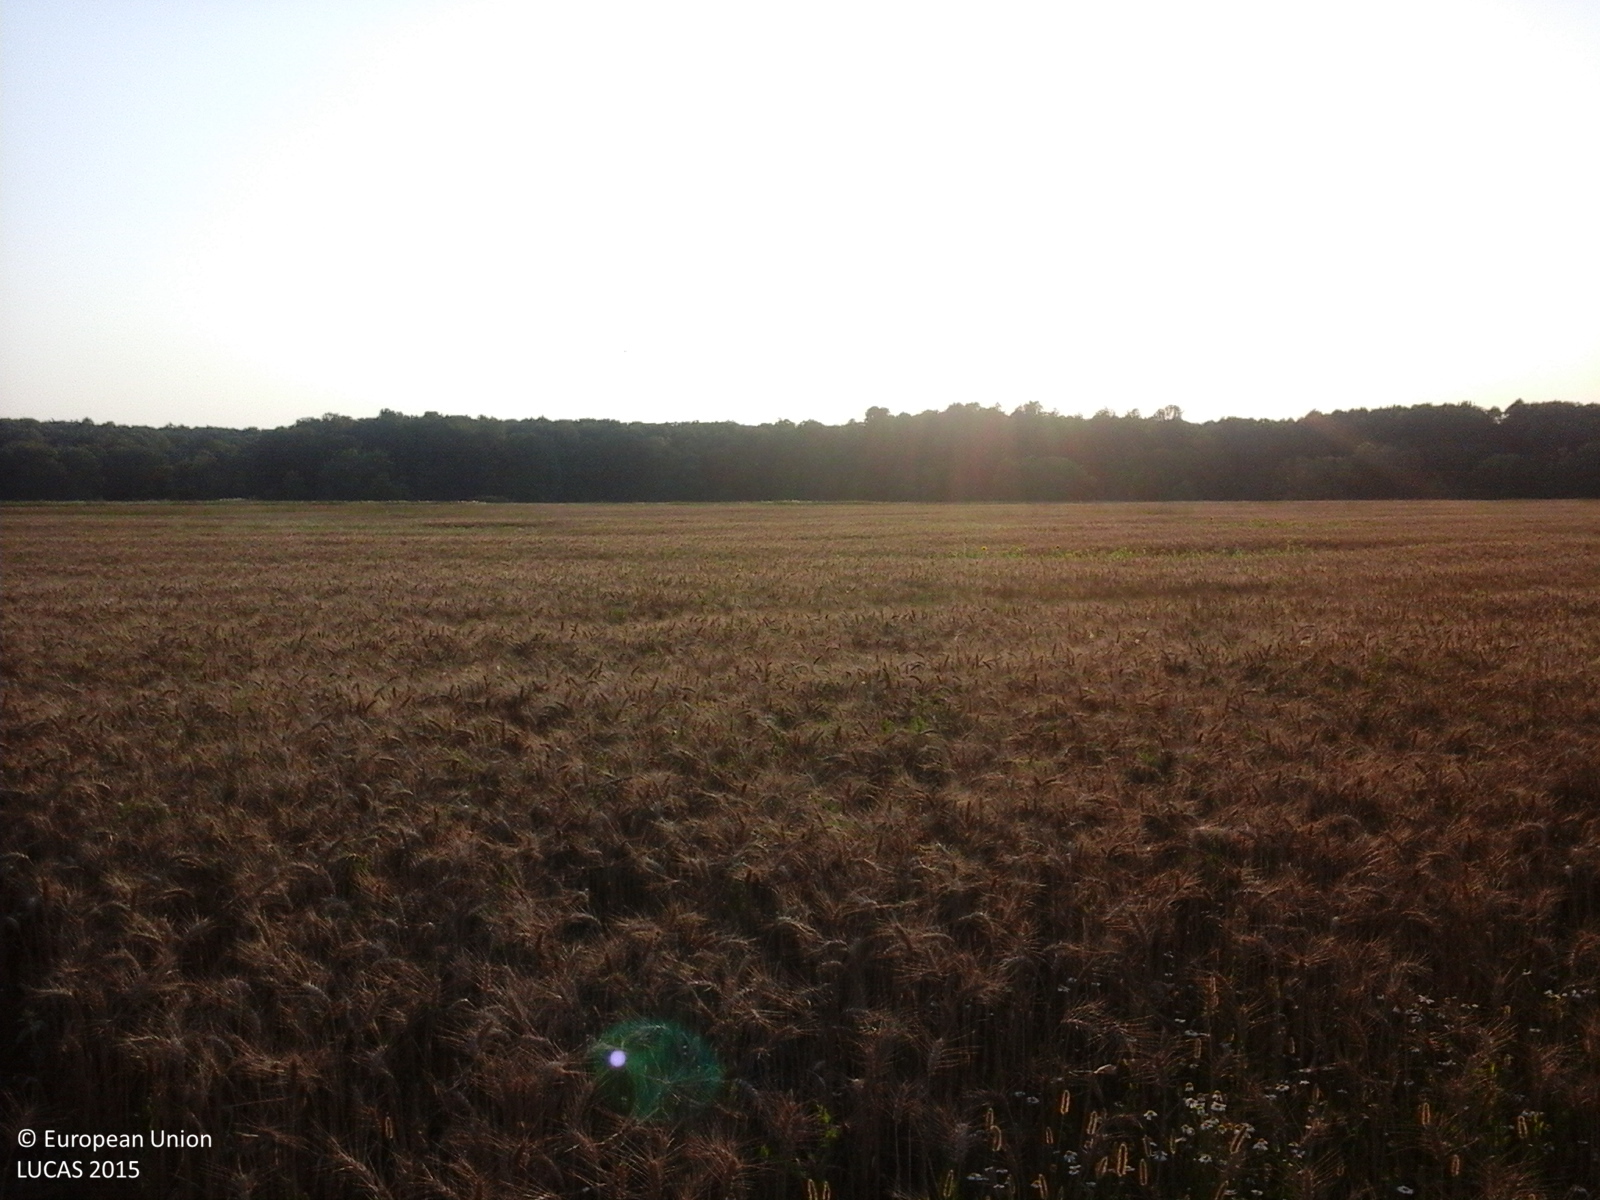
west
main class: Cropland
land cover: Common wheat
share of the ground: > 75 %
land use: Agriculture (excluding fallow land and kitchen gardens)
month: July
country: RO
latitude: 44.7080
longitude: 25.6861
